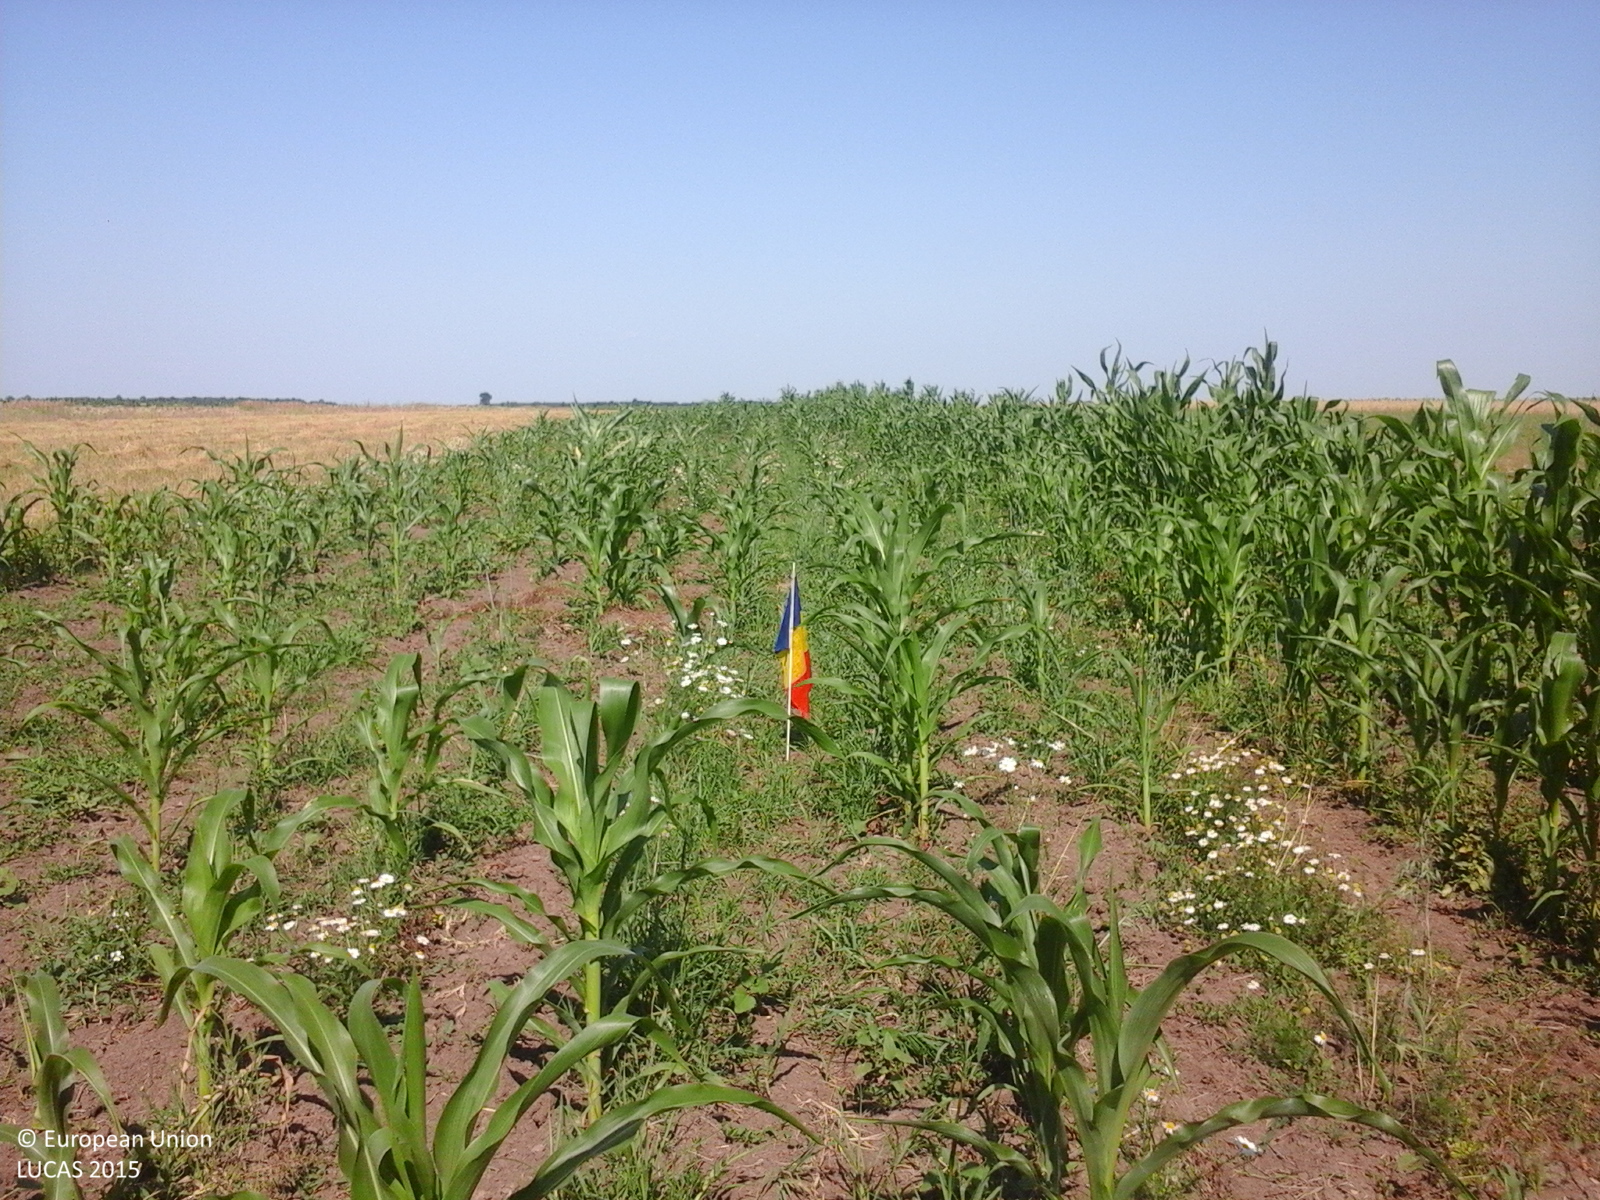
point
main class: Cropland
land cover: Maize
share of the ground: 50 - 75 %
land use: Agriculture (excluding fallow land and kitchen gardens)
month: July
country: RO
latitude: 44.5153
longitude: 24.6291
